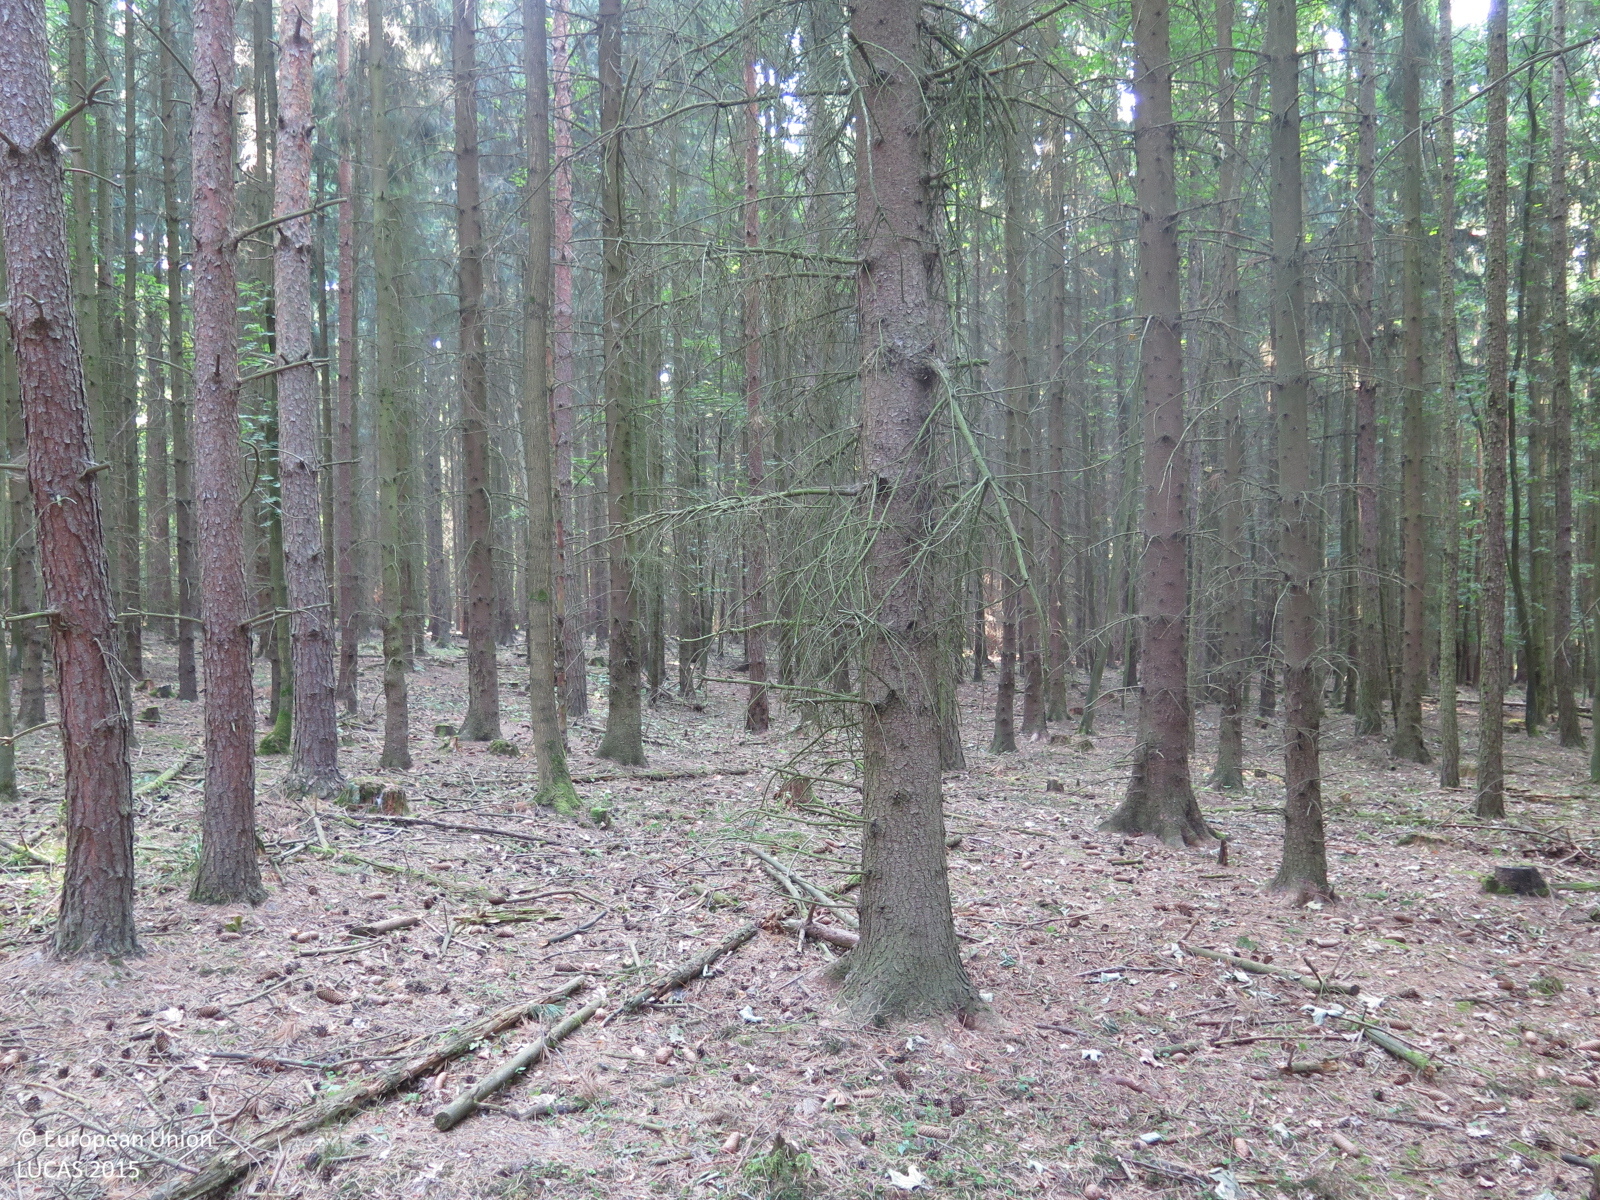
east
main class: Woodland
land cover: Other coniferous woodland
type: hemiboreal forest and nemoral coniferous forest and mixed broadleaved-coniferous forest
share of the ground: > 75 %
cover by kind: coniferous forest trees 90 %, broadleaved forest trees 5 %, herbaceous plants 5 %
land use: Forestry
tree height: > 5 m
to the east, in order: Other coniferous woodland; Spruce dominated coniferous woodland; Tracks; Spruce dominated coniferous woodland; Broadleaved woodland; Tracks; Pine dominated coniferous woodland
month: August
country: CZ
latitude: 50.0835
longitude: 13.8439
